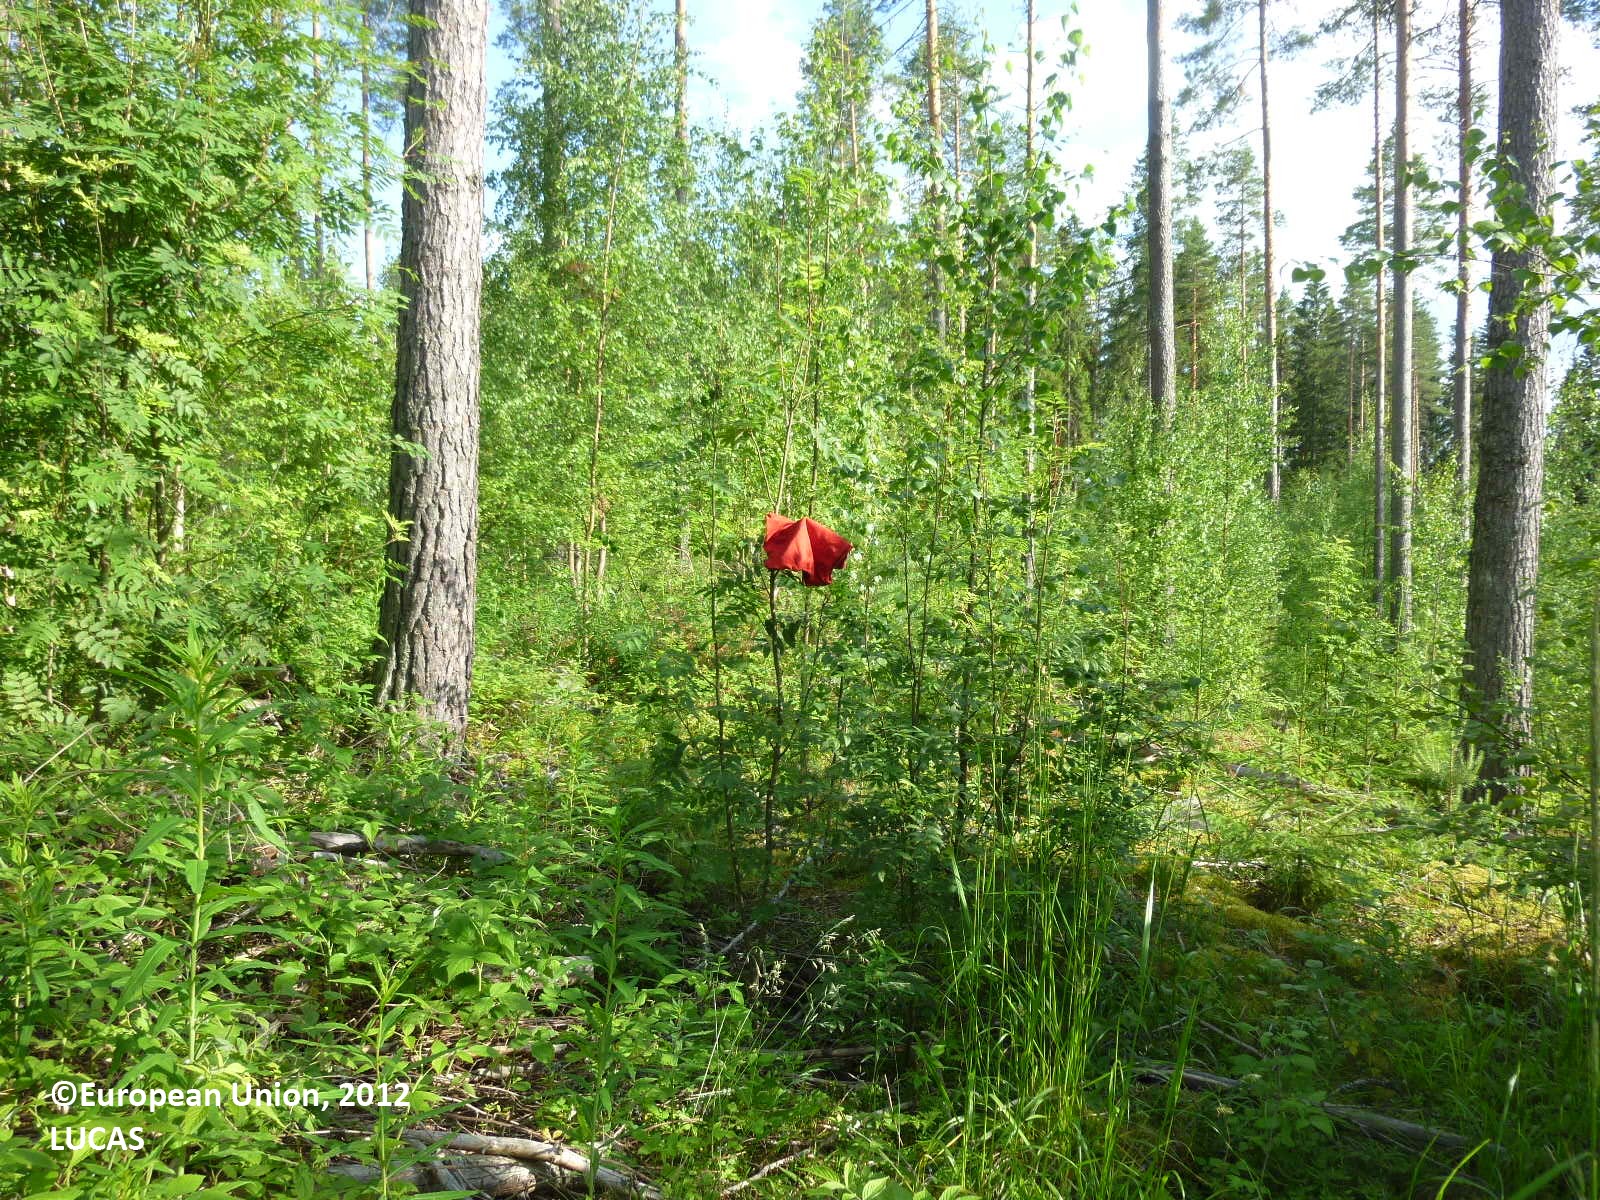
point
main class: Woodland
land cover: Pine dominated mixed woodland
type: boreal forest
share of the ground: 50 - 75 %
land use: Forestry
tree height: > 5 m
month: July
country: FI
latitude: 61.3878
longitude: 22.3609
